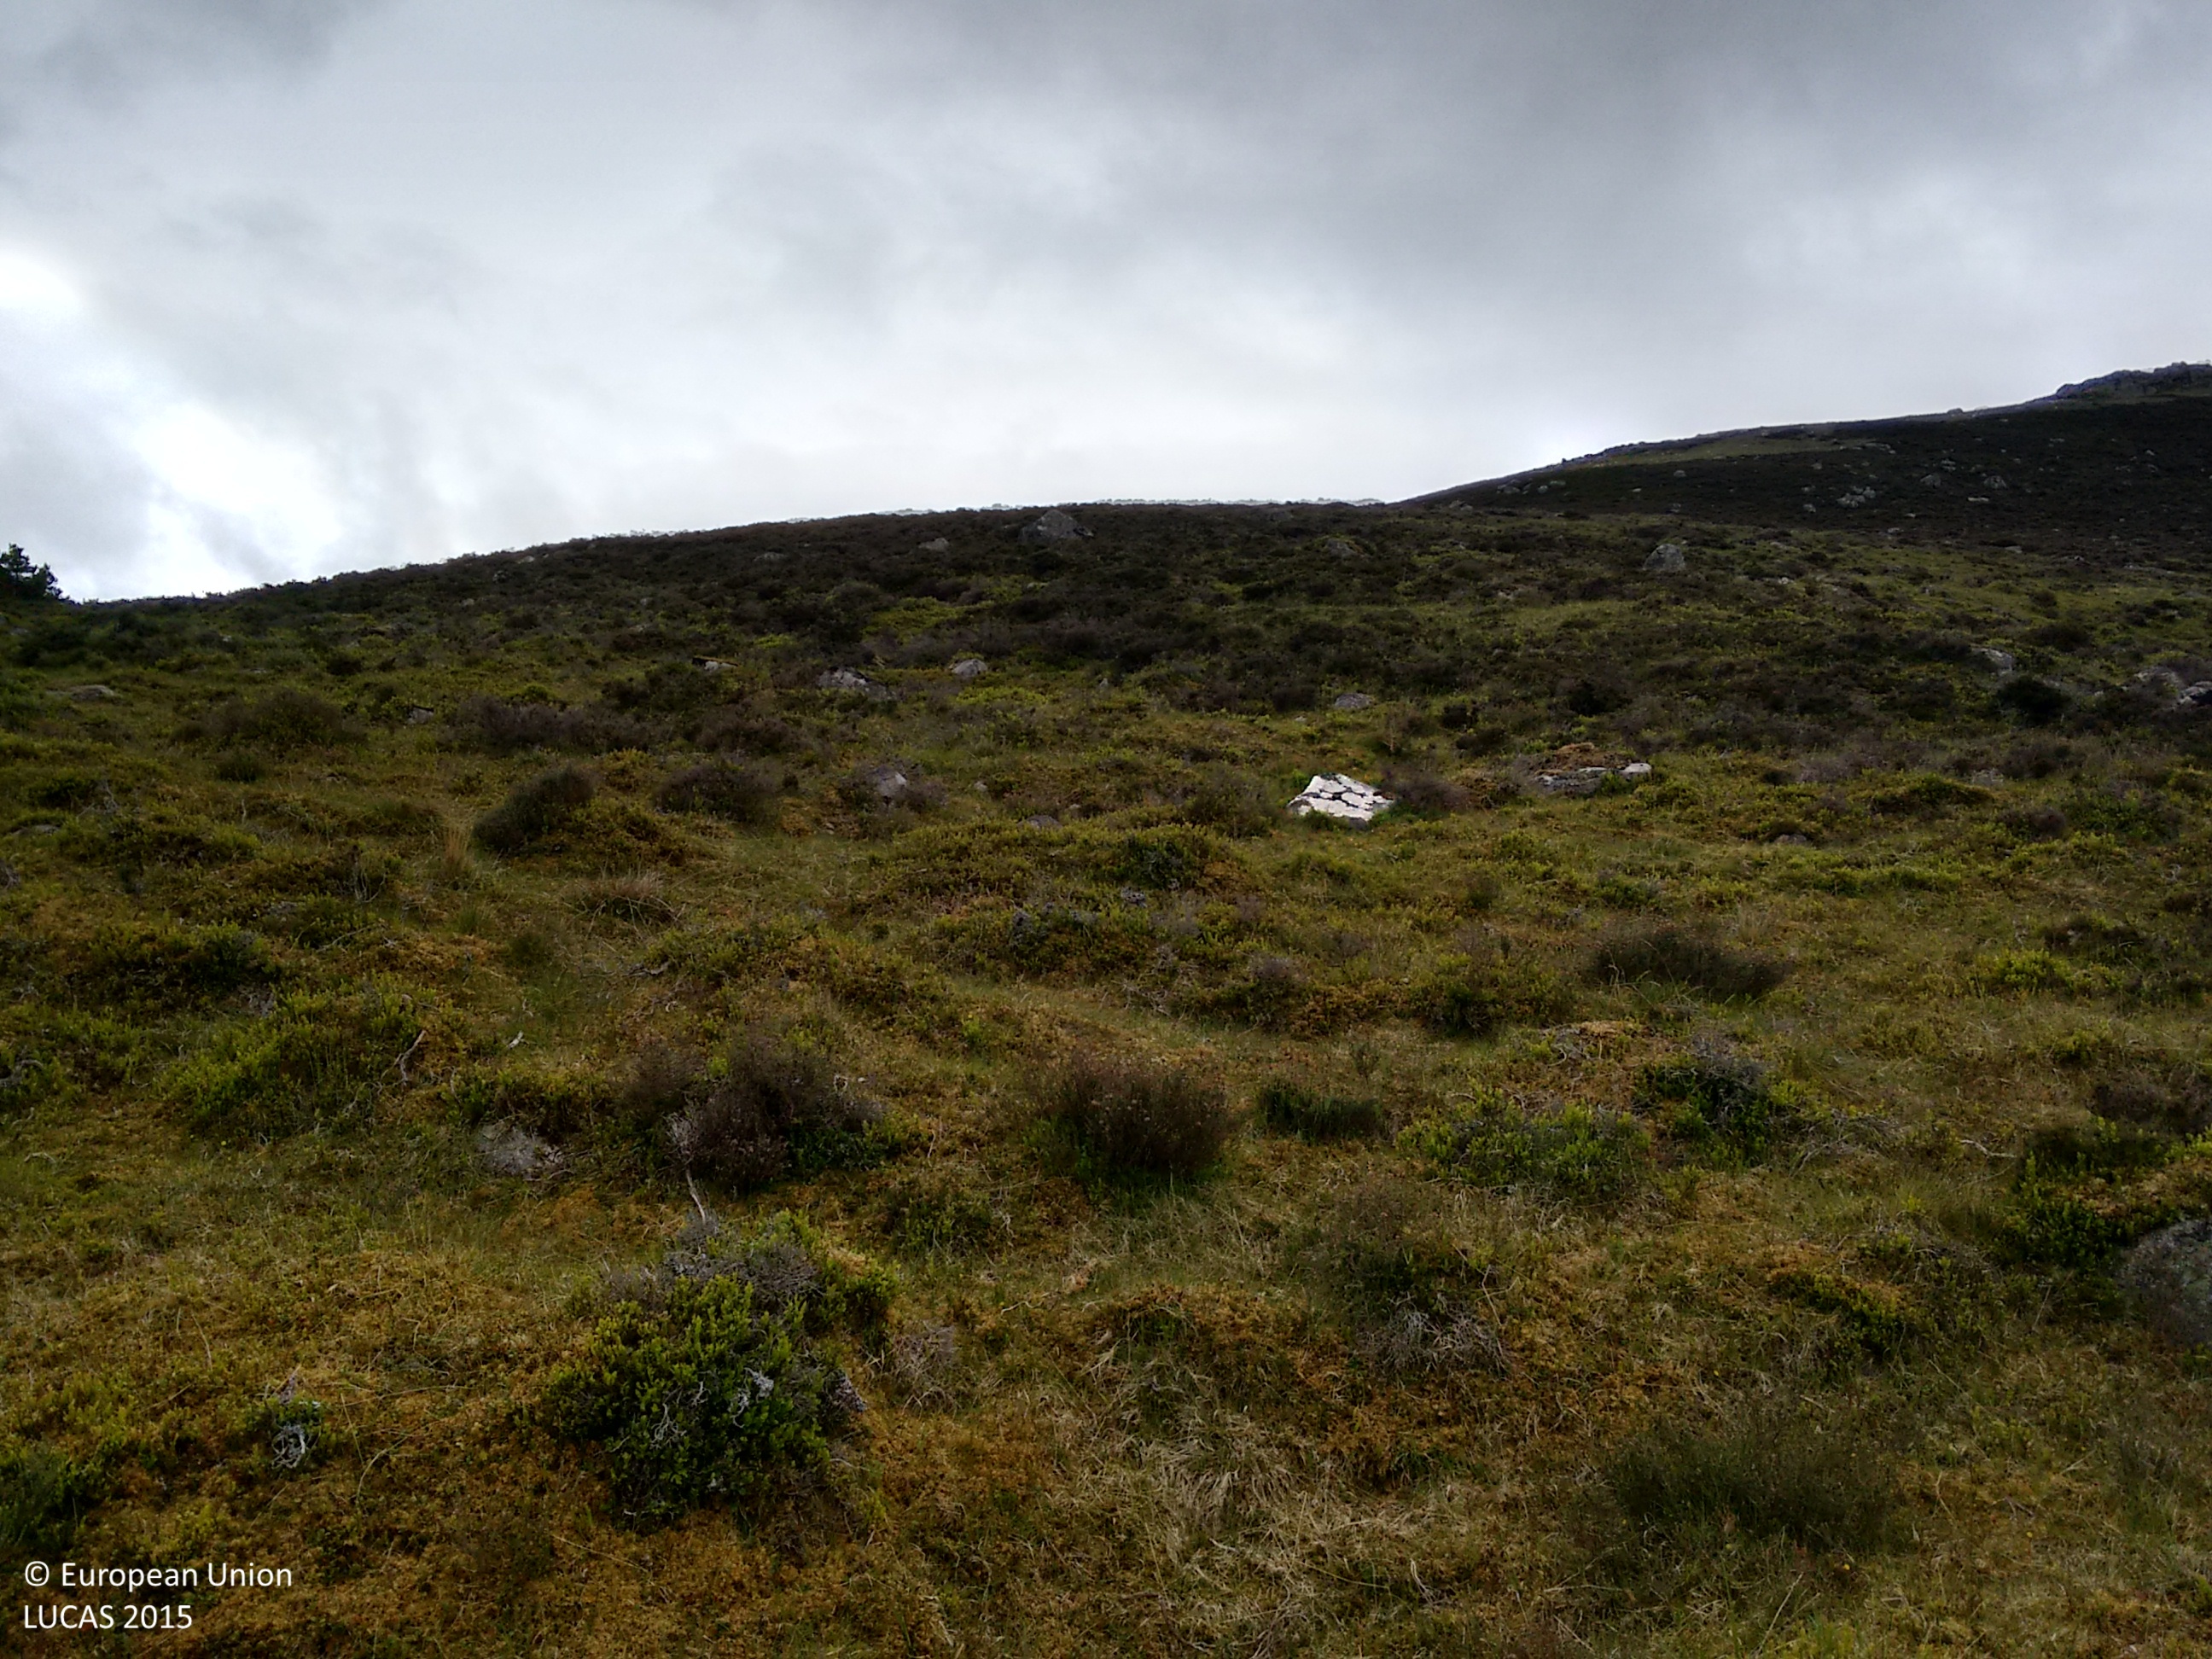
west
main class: Shrubland
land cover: Shrubland without tree cover
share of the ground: > 75 %
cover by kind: shrubs 80 %, herbaceous plants 10 %, lichens and mosses 5 %
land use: Semi-natural and natural areas not in use
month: June
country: GB
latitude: 56.9887
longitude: -3.1167
